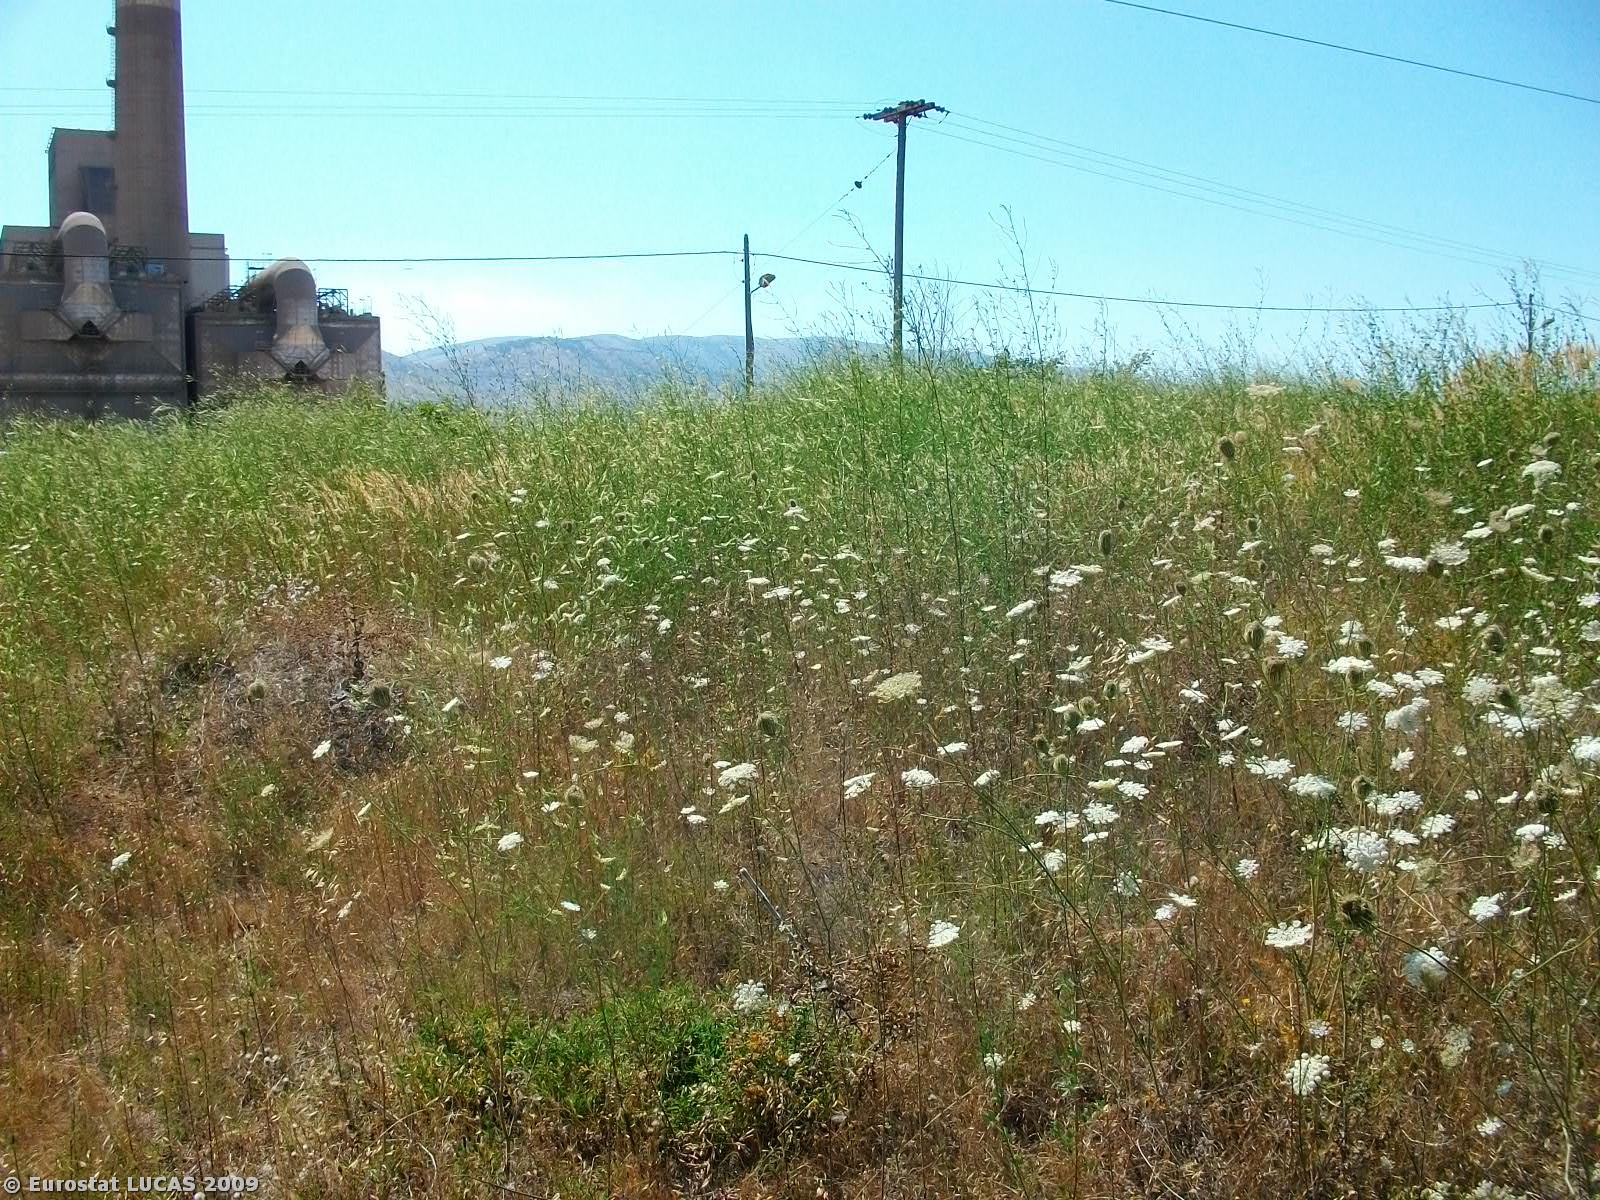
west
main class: Grassland
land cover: Grassland without tree/shrub cover
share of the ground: 50 - 75 %
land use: Unused
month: July
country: GR
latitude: 40.4122
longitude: 21.7893
